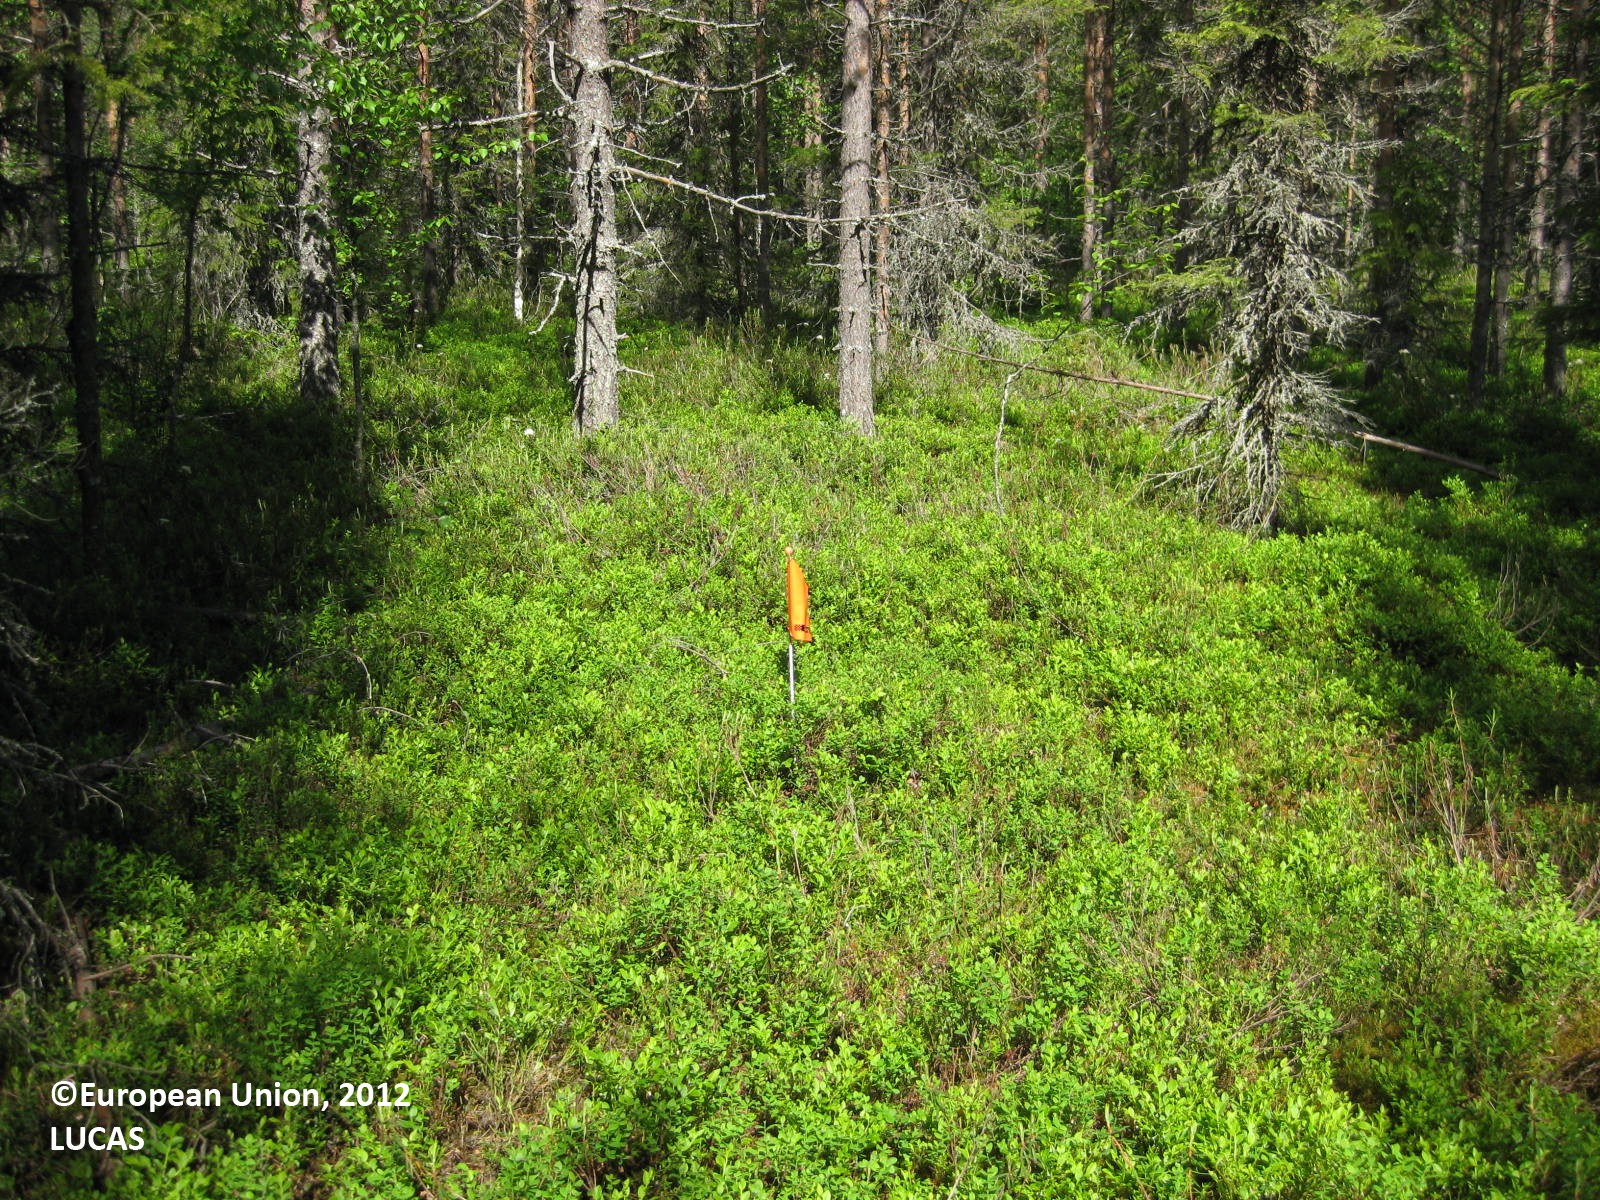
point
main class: Woodland
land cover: Other coniferous woodland
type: boreal forest
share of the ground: 50 - 75 %
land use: Forestry
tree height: > 5 m
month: June
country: FI
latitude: 65.3743
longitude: 28.2874
